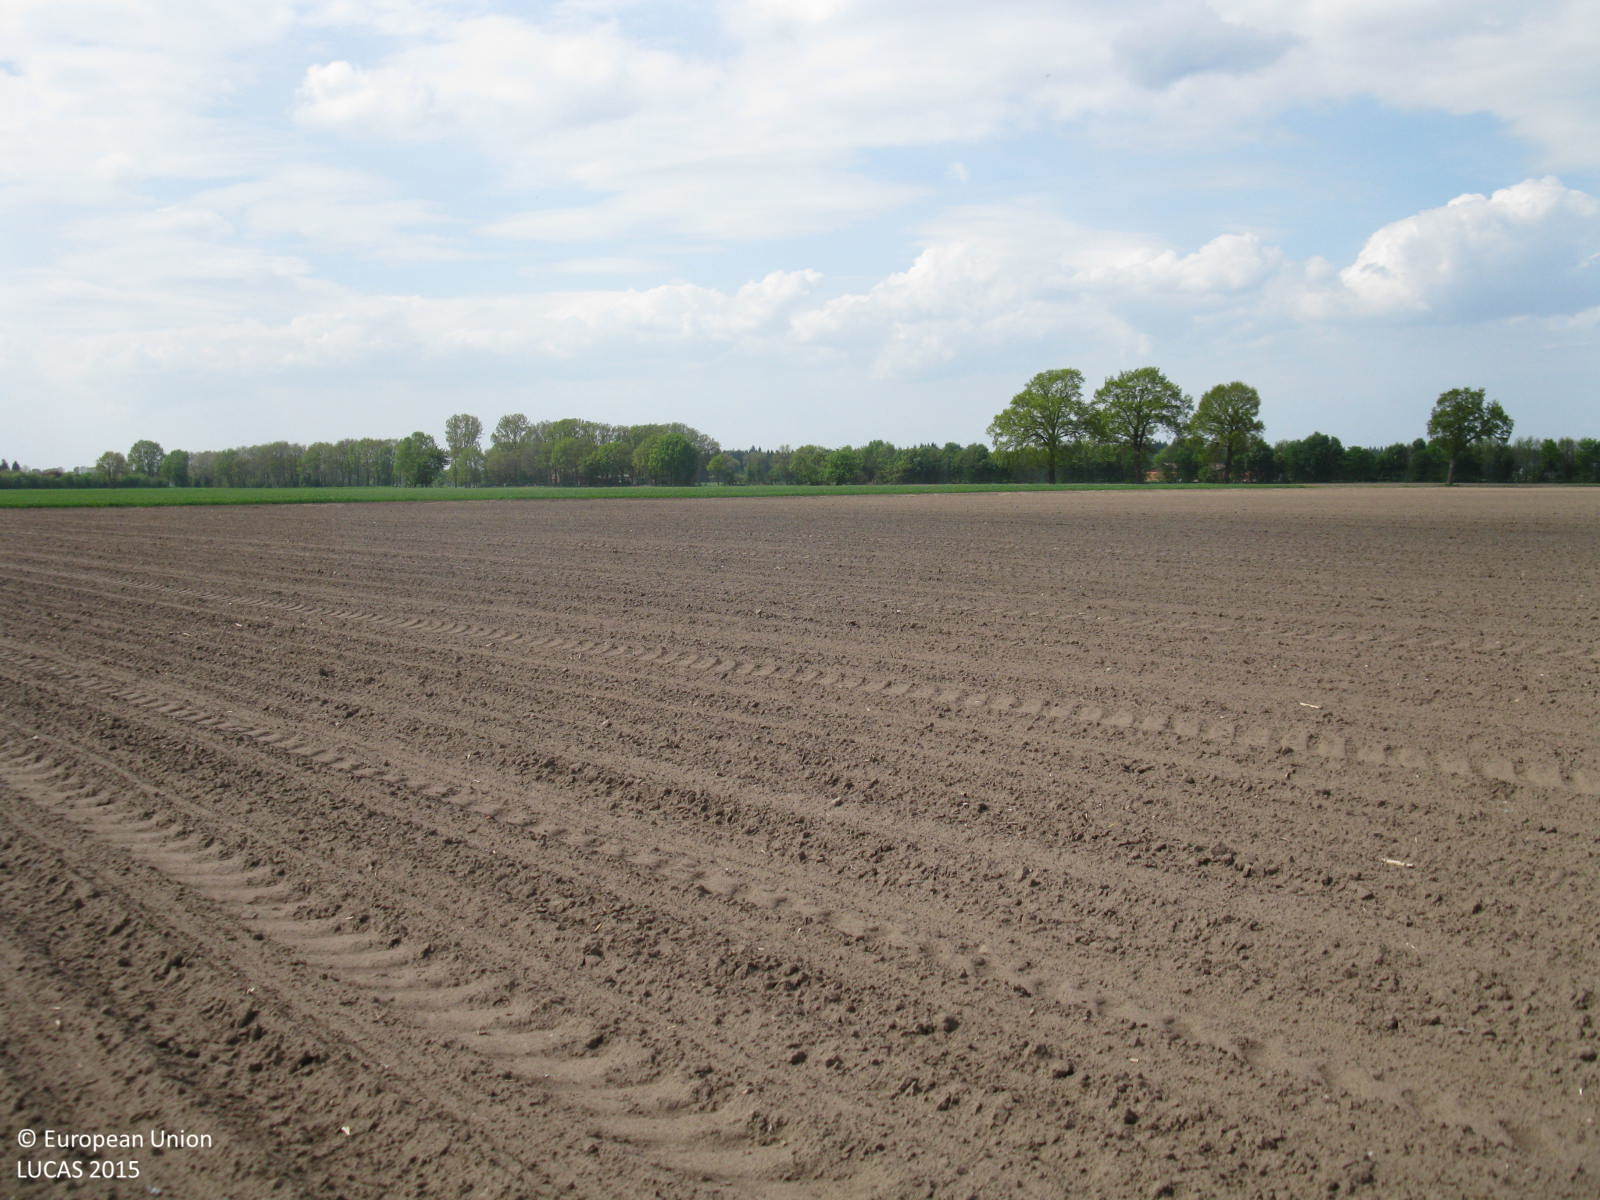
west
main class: Cropland
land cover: Maize
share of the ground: > 75 %
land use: Agriculture (excluding fallow land and kitchen gardens)
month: May
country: DE
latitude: 52.8276
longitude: 7.9673
